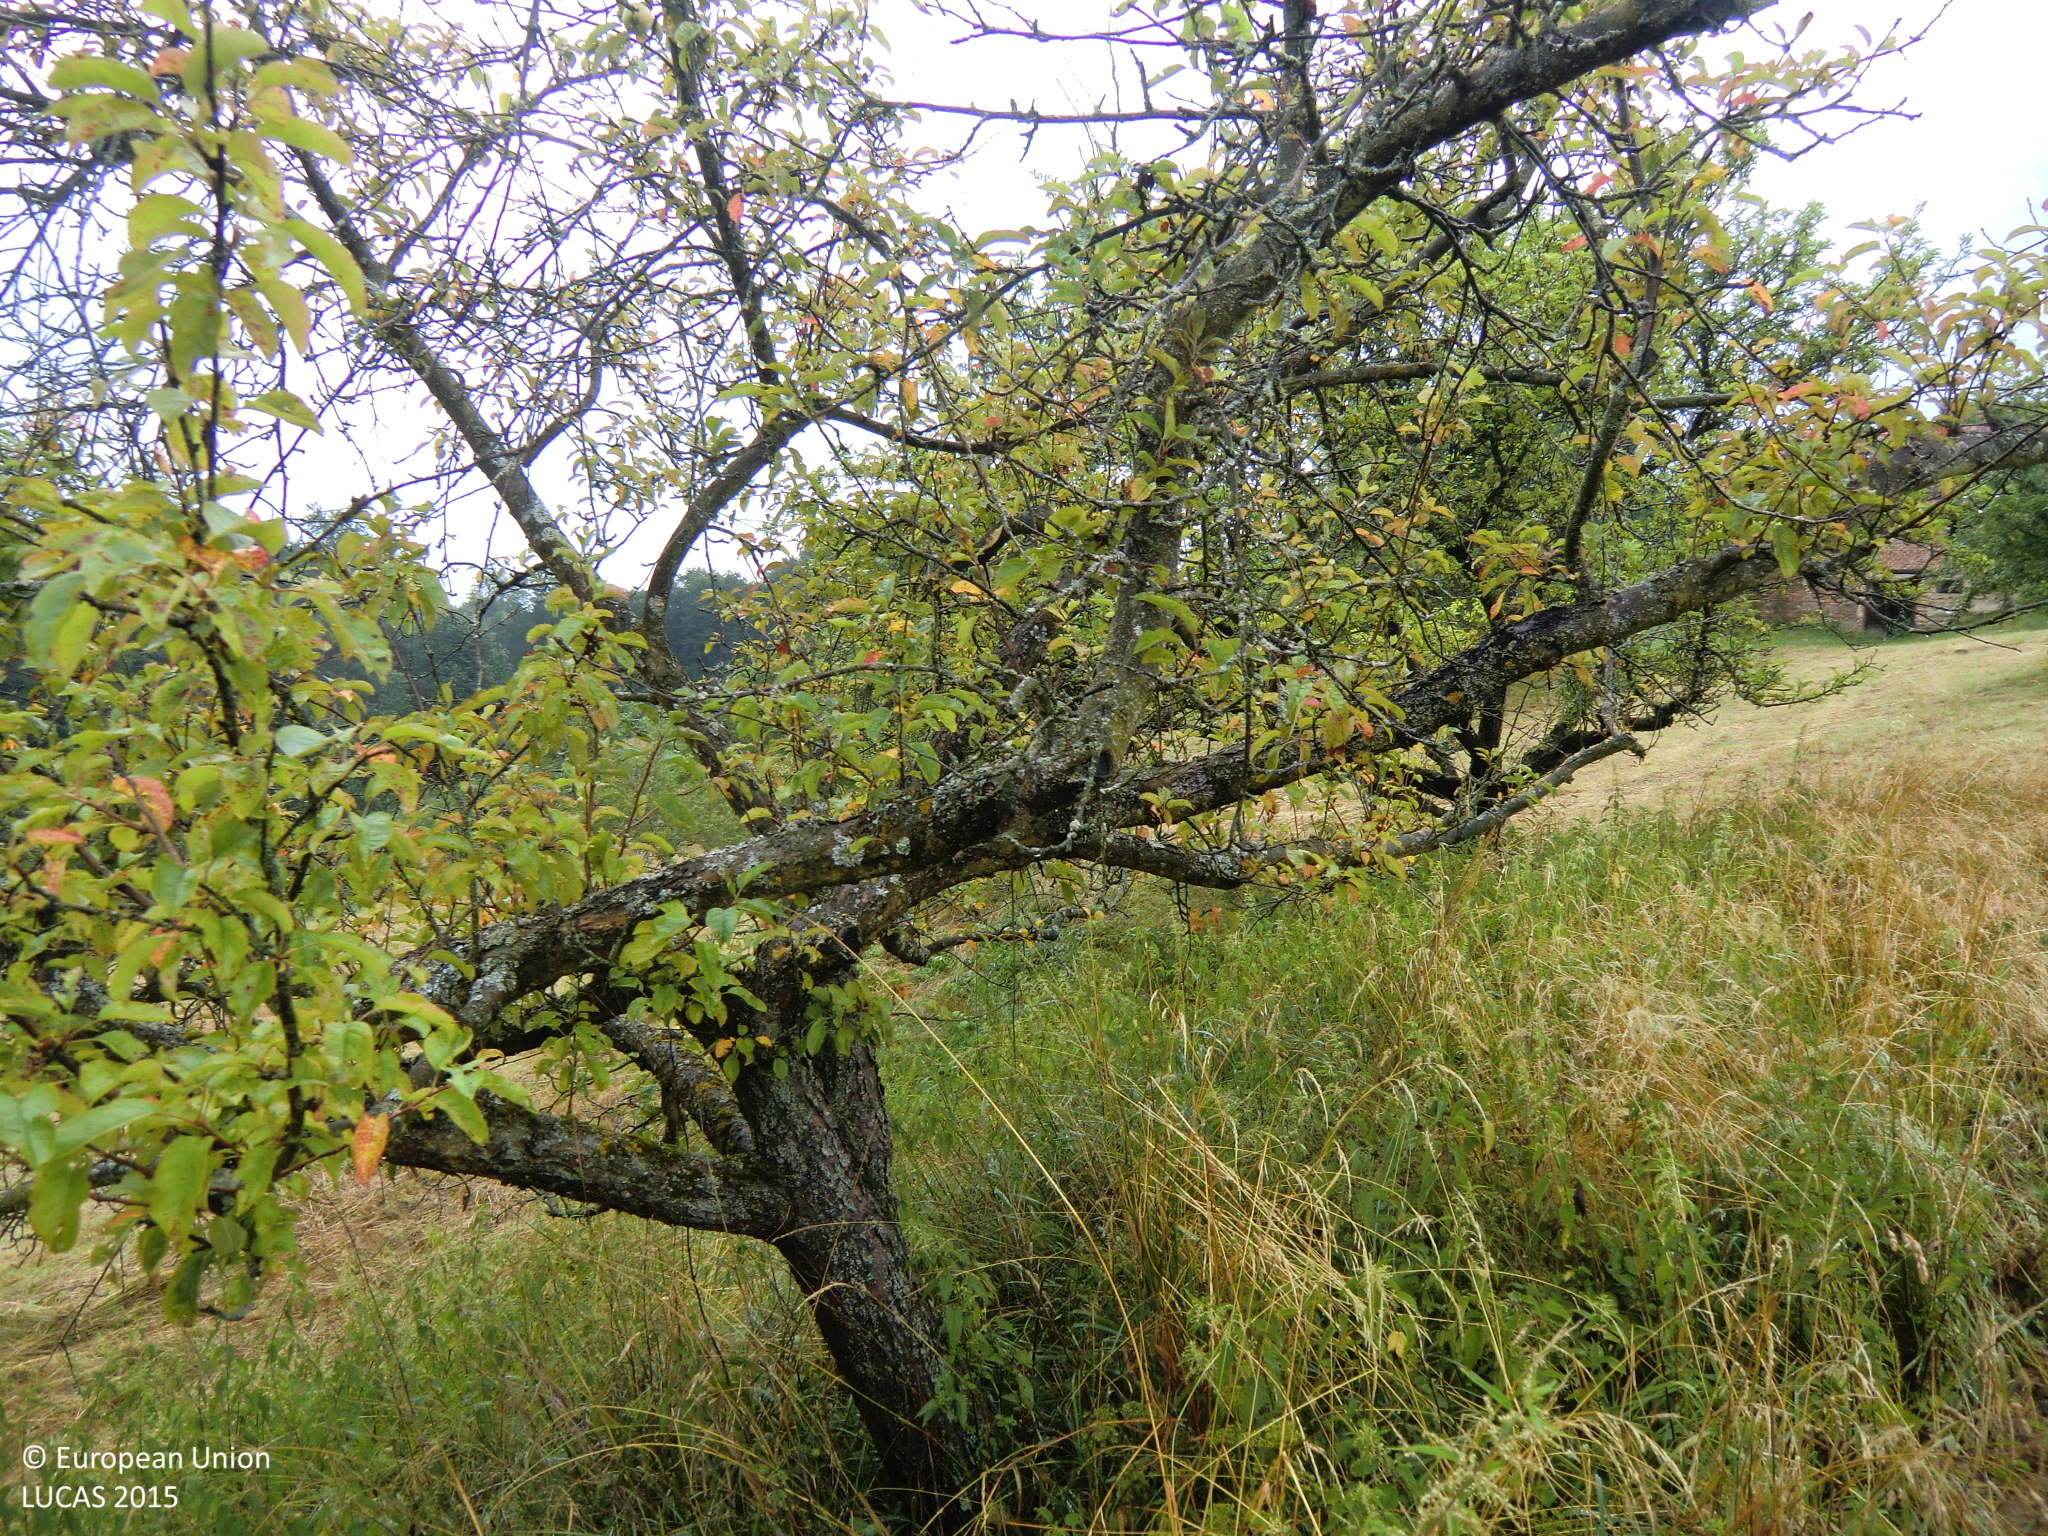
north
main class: Cropland
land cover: Apple fruit
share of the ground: 50 - 75 %
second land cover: Grassland without tree/shrub cover
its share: > 75 %
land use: Agriculture (excluding fallow land and kitchen gardens)
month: July
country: AT
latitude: 47.0184
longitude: 15.9077
